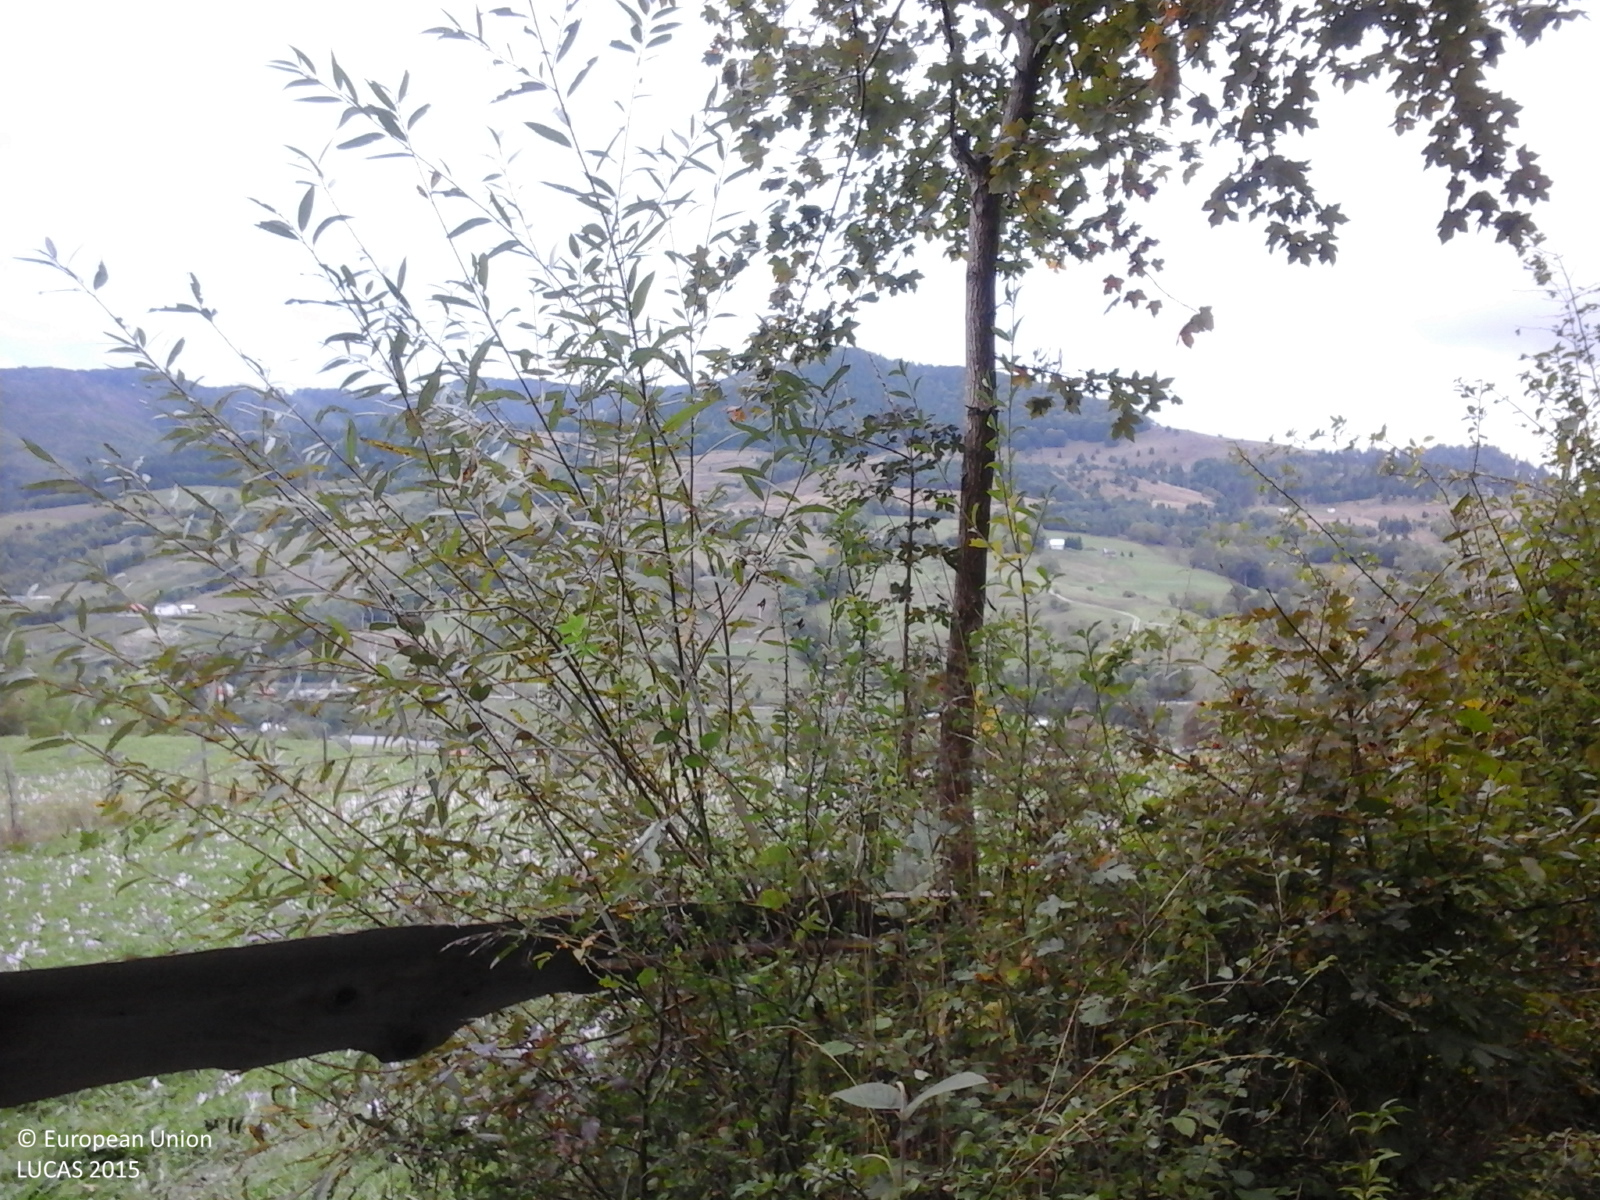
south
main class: Woodland
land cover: Broadleaved woodland
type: broadleaved evergreen forest
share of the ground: > 75 %
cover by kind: broadleaved forest trees 100 %
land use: Forestry
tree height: > 5 m
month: October
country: RO
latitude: 46.2741
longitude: 23.0746
